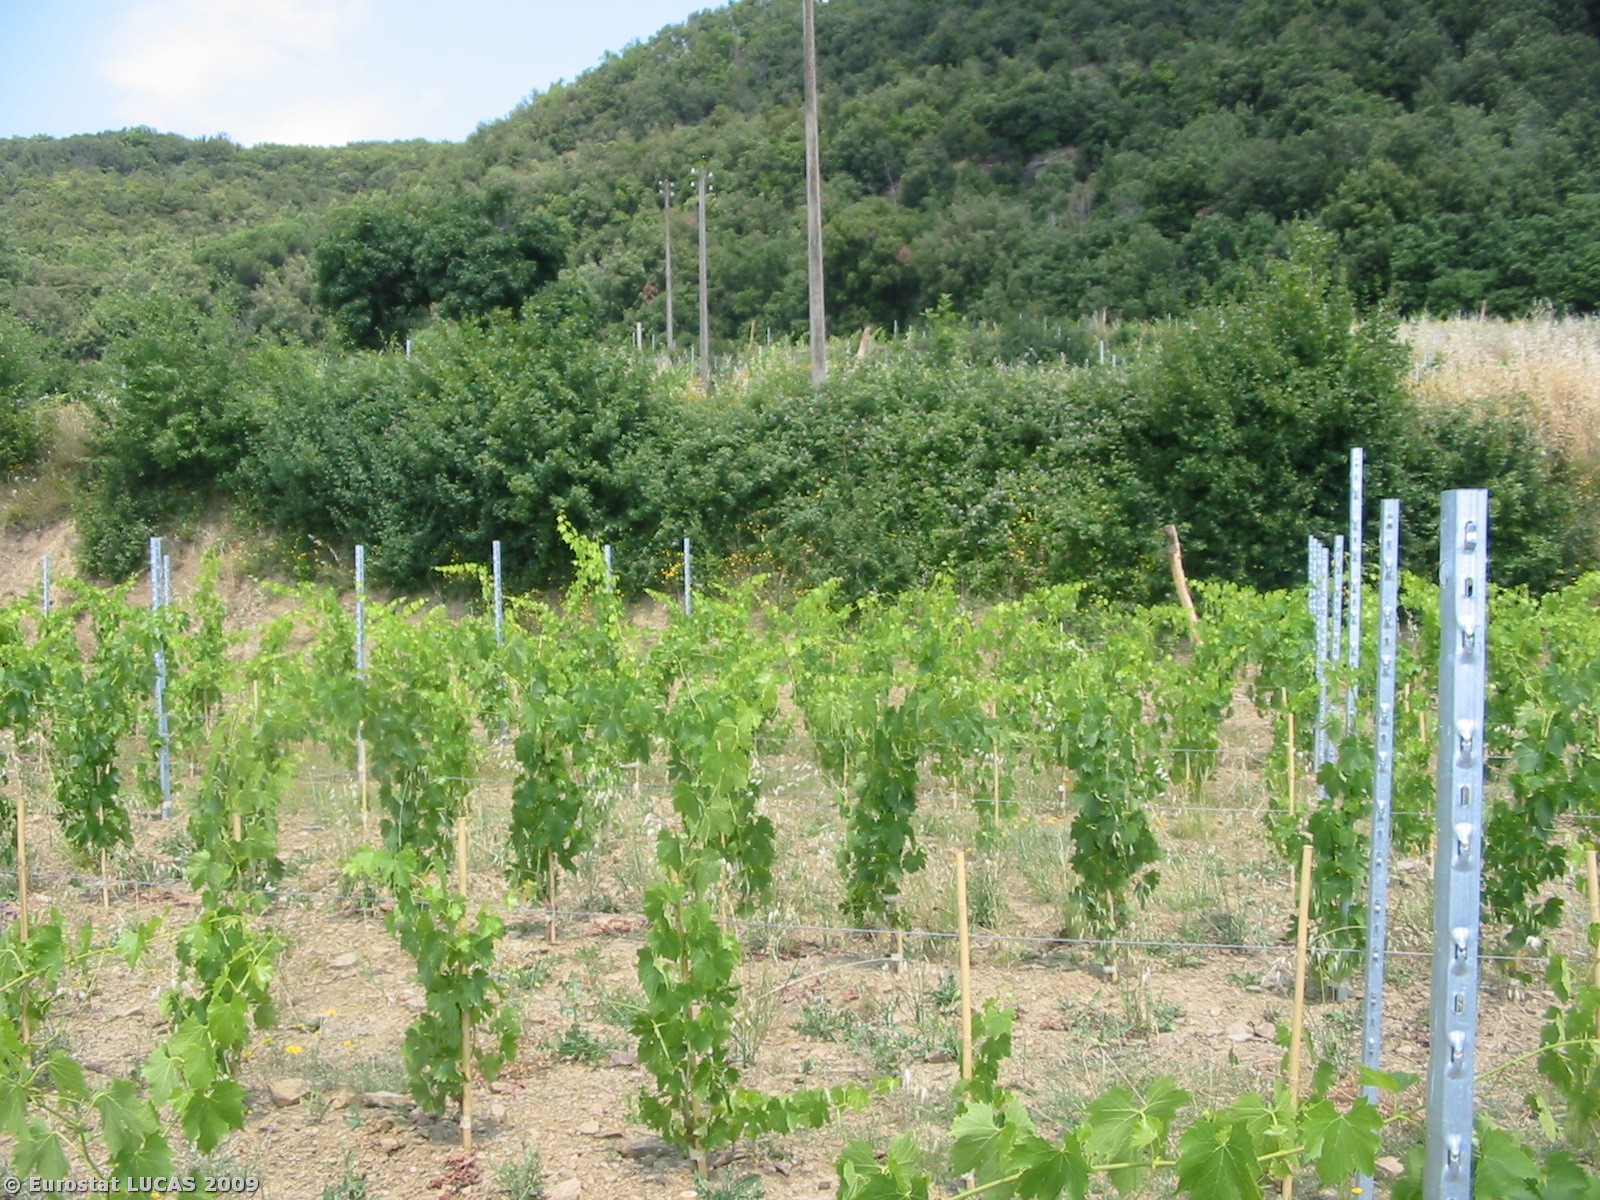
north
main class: Cropland
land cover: Vineyards
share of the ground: 25 - 50 %
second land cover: Grassland with sparse tree/shrub cover
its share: > 75 %
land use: Agriculture (excluding fallow land and kitchen gardens)
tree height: < 5 m
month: June
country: IT
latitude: 43.3580
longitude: 11.9317
